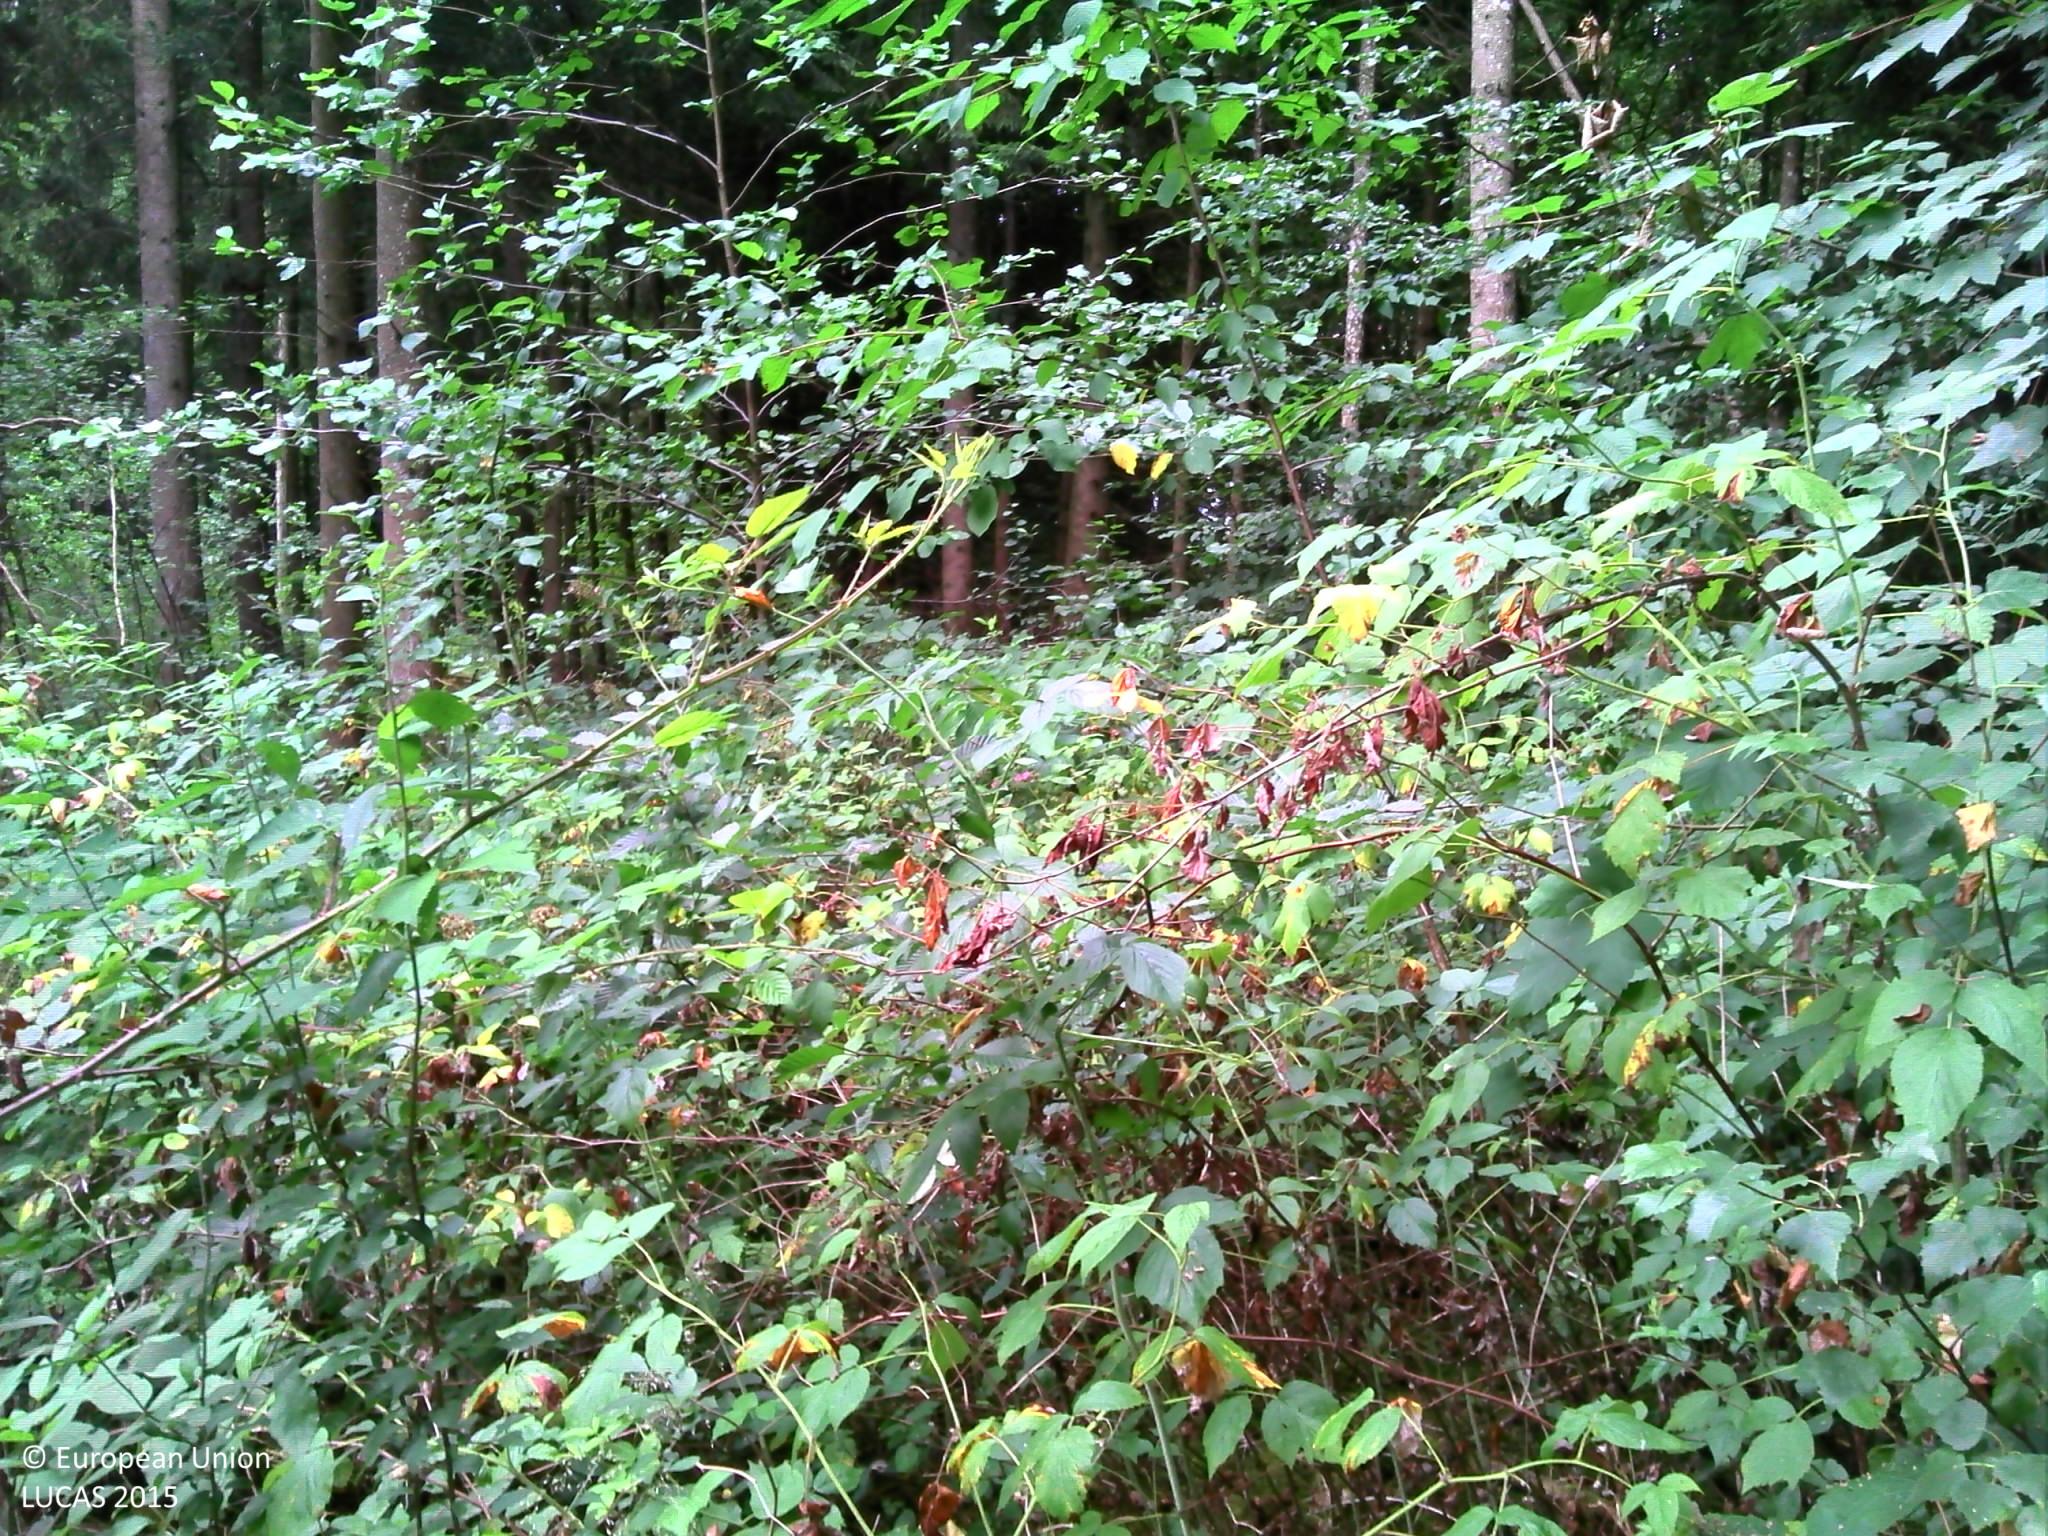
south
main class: Woodland
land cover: Spruce dominated coniferous woodland
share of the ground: 50 - 75 %
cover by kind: coniferous forest trees 60 %, shrubs 25 %, herbaceous plants 10 %, broadleaved forest trees 5 %
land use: Forestry
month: July
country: BE
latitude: 49.6875
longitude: 5.6602
